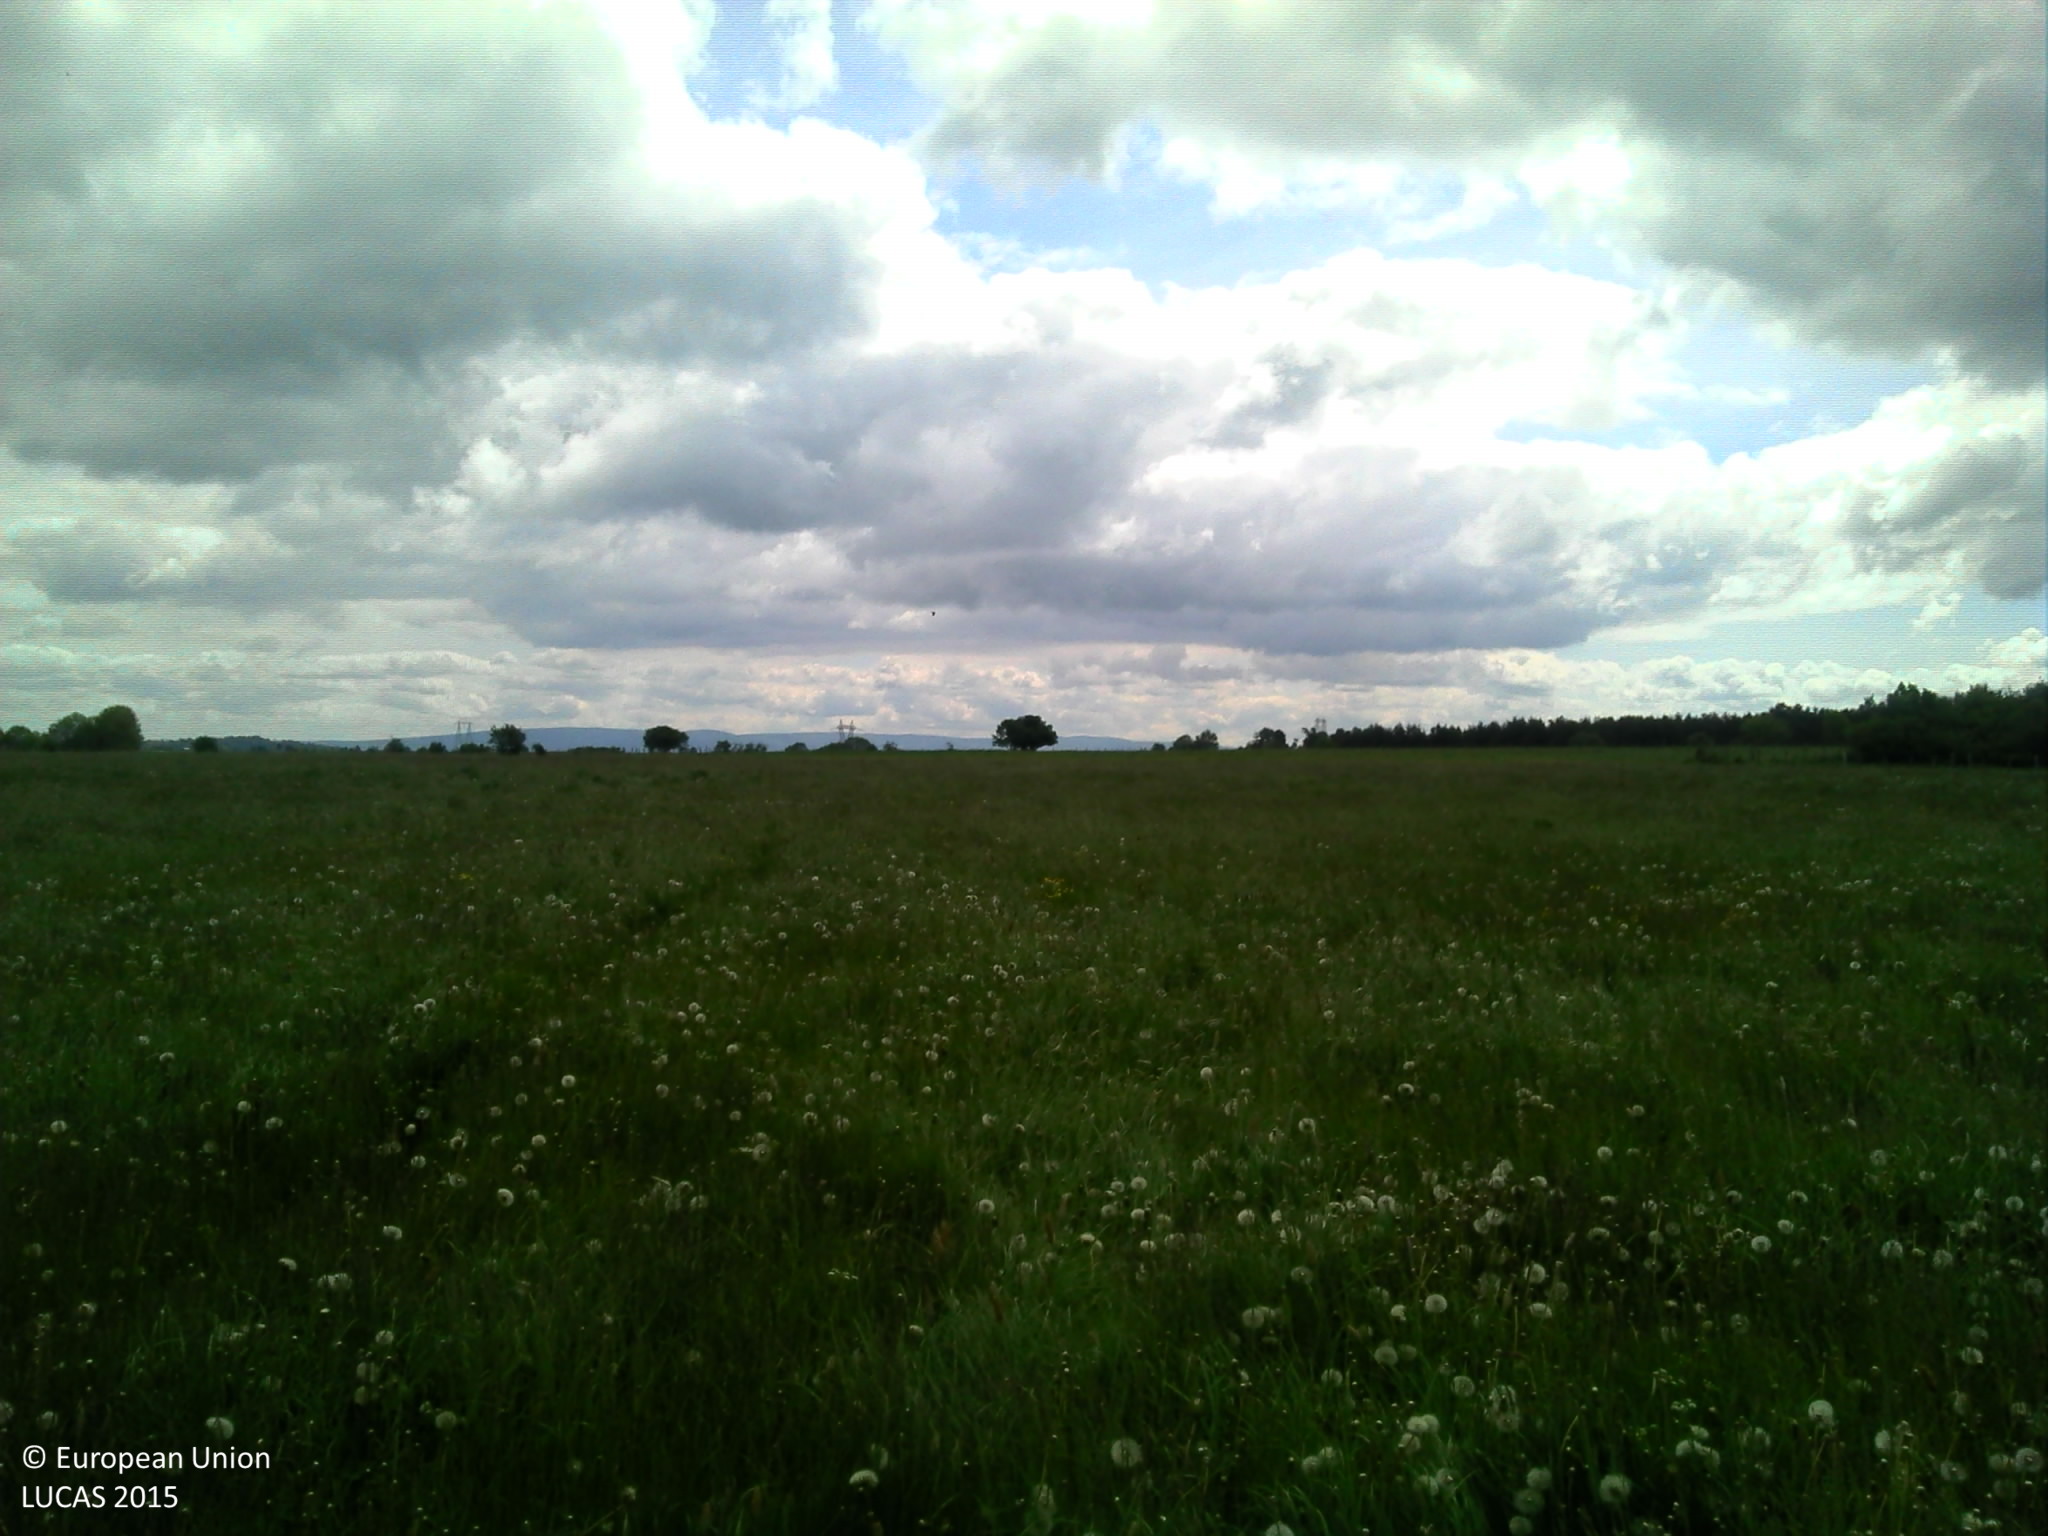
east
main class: Grassland
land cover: Grassland without tree/shrub cover
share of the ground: > 75 %
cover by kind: herbaceous plants 100 %
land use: Agriculture (excluding fallow land and kitchen gardens)
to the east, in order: Grassland without tree/shrub cover
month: May
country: FR
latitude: 44.9784
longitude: 2.9386
